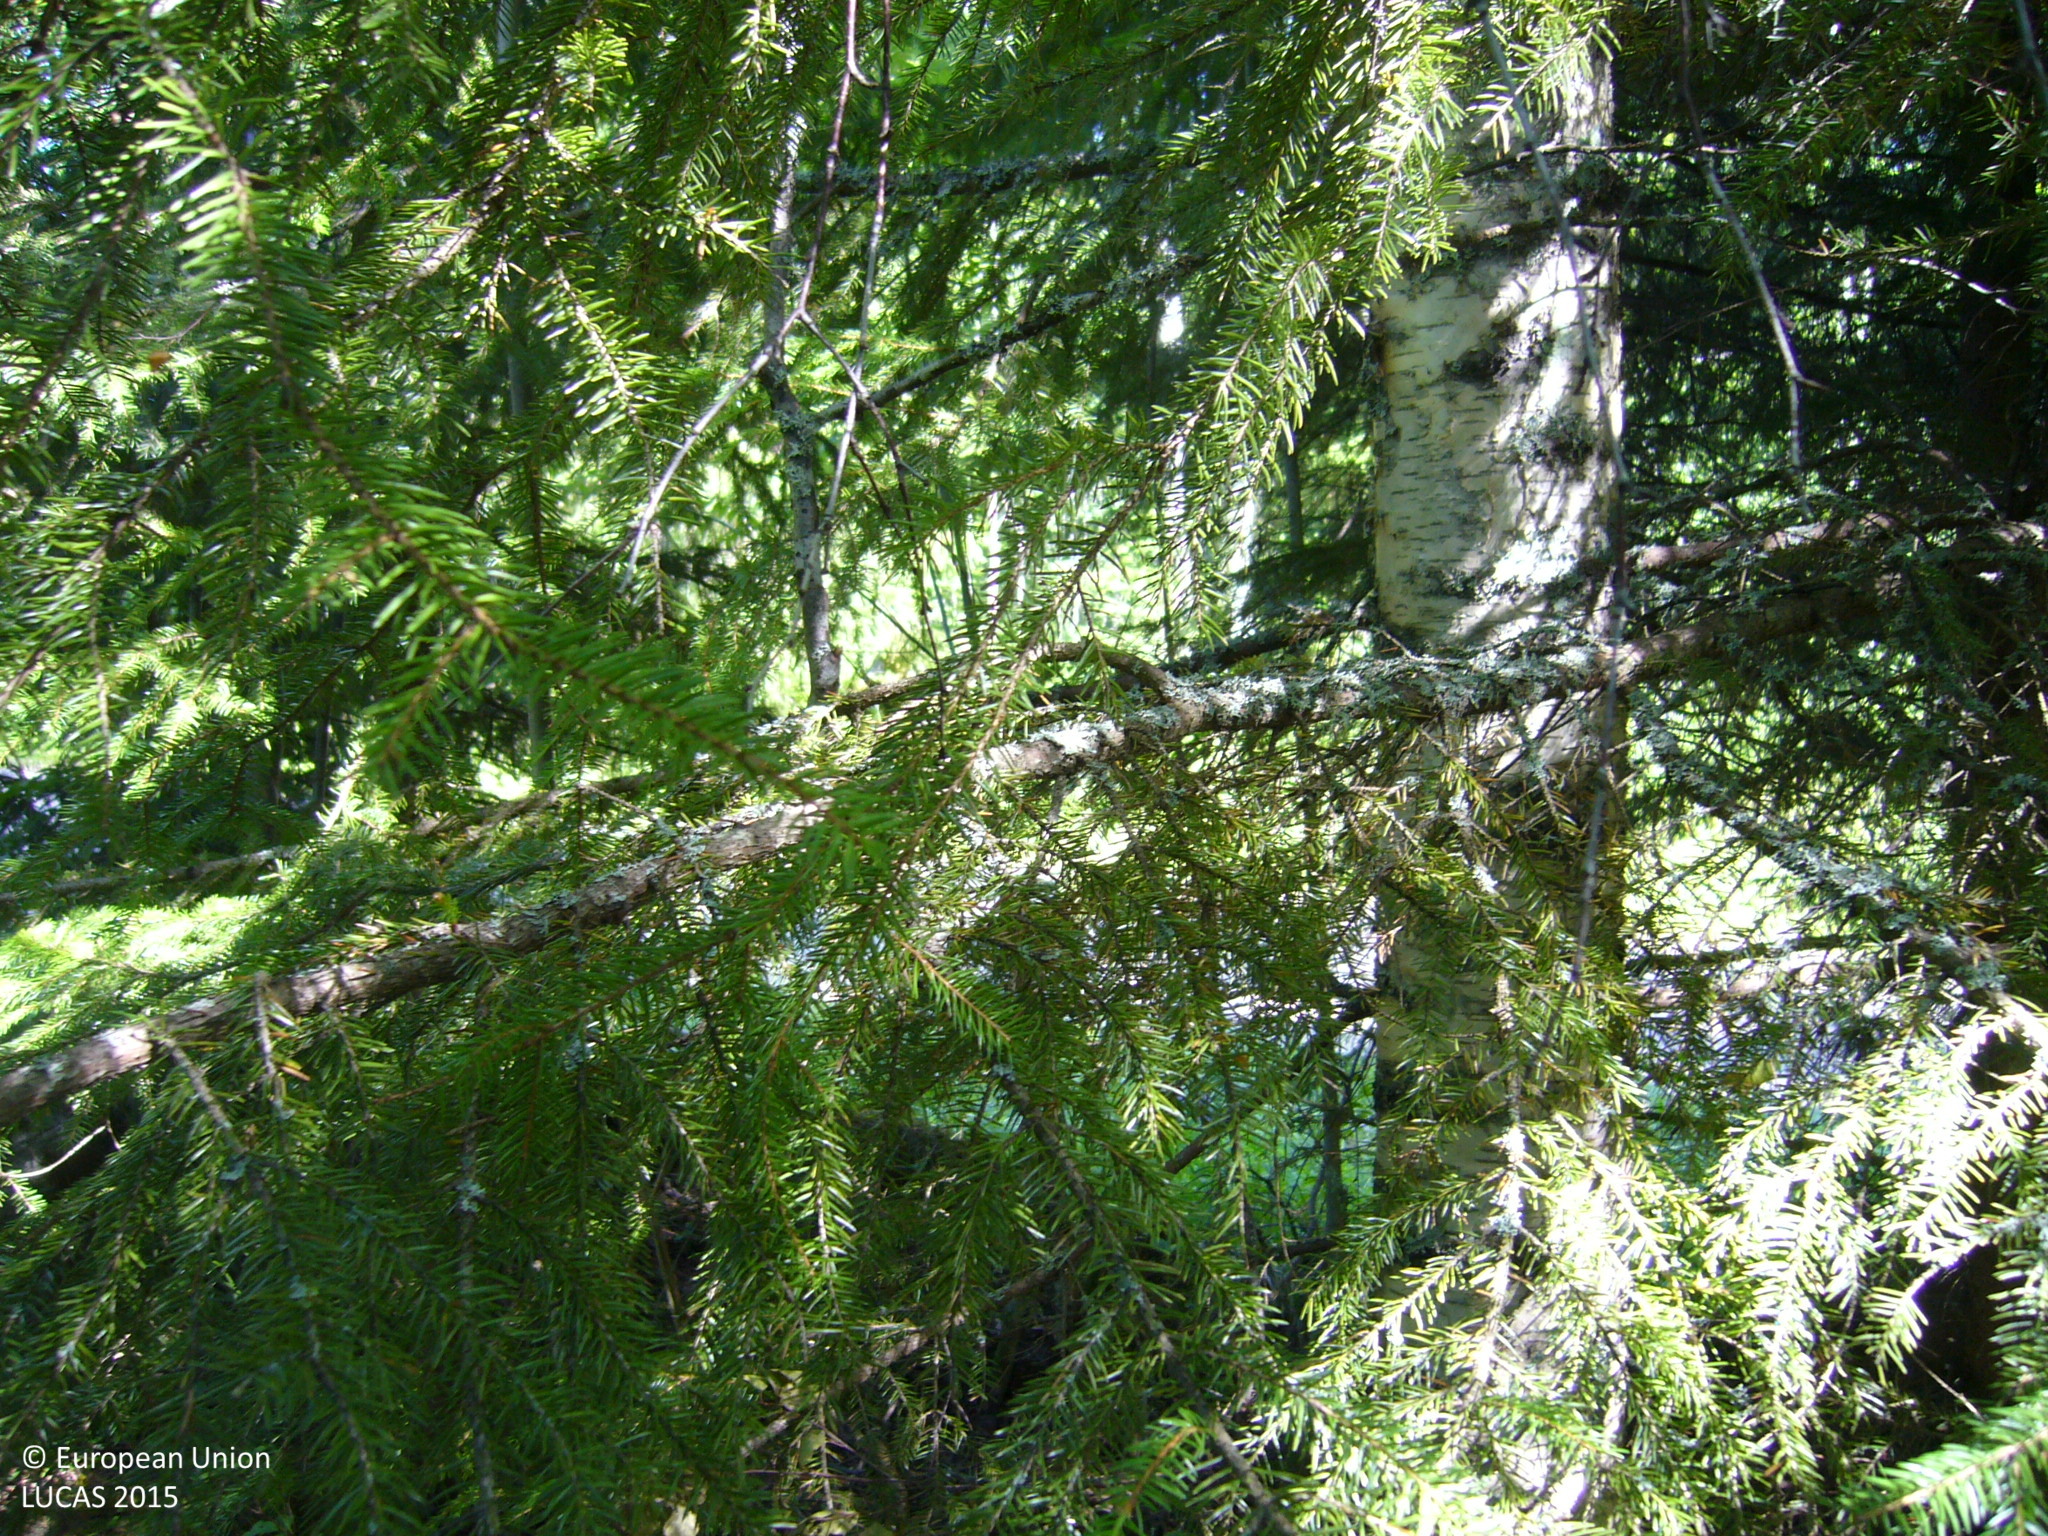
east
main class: Woodland
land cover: Spruce dominated mixed woodland
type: boreal forest
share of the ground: > 75 %
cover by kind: coniferous forest trees 50 %, broadleaved forest trees 40 %, shrubs 10 %
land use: Forestry
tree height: > 5 m
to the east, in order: Spruce dominated mixed woodland; Ditches and canals; Grass margins; Paved roads, cycling and walking lanes; Grass margins; Ditches and canals; Other mixed woodland; Spruce dominated mixed woodland; Tracks; Pine dominated mixed woodland; Pine dominated coniferous woodland
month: July
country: FI
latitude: 63.4081
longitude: 26.0342
